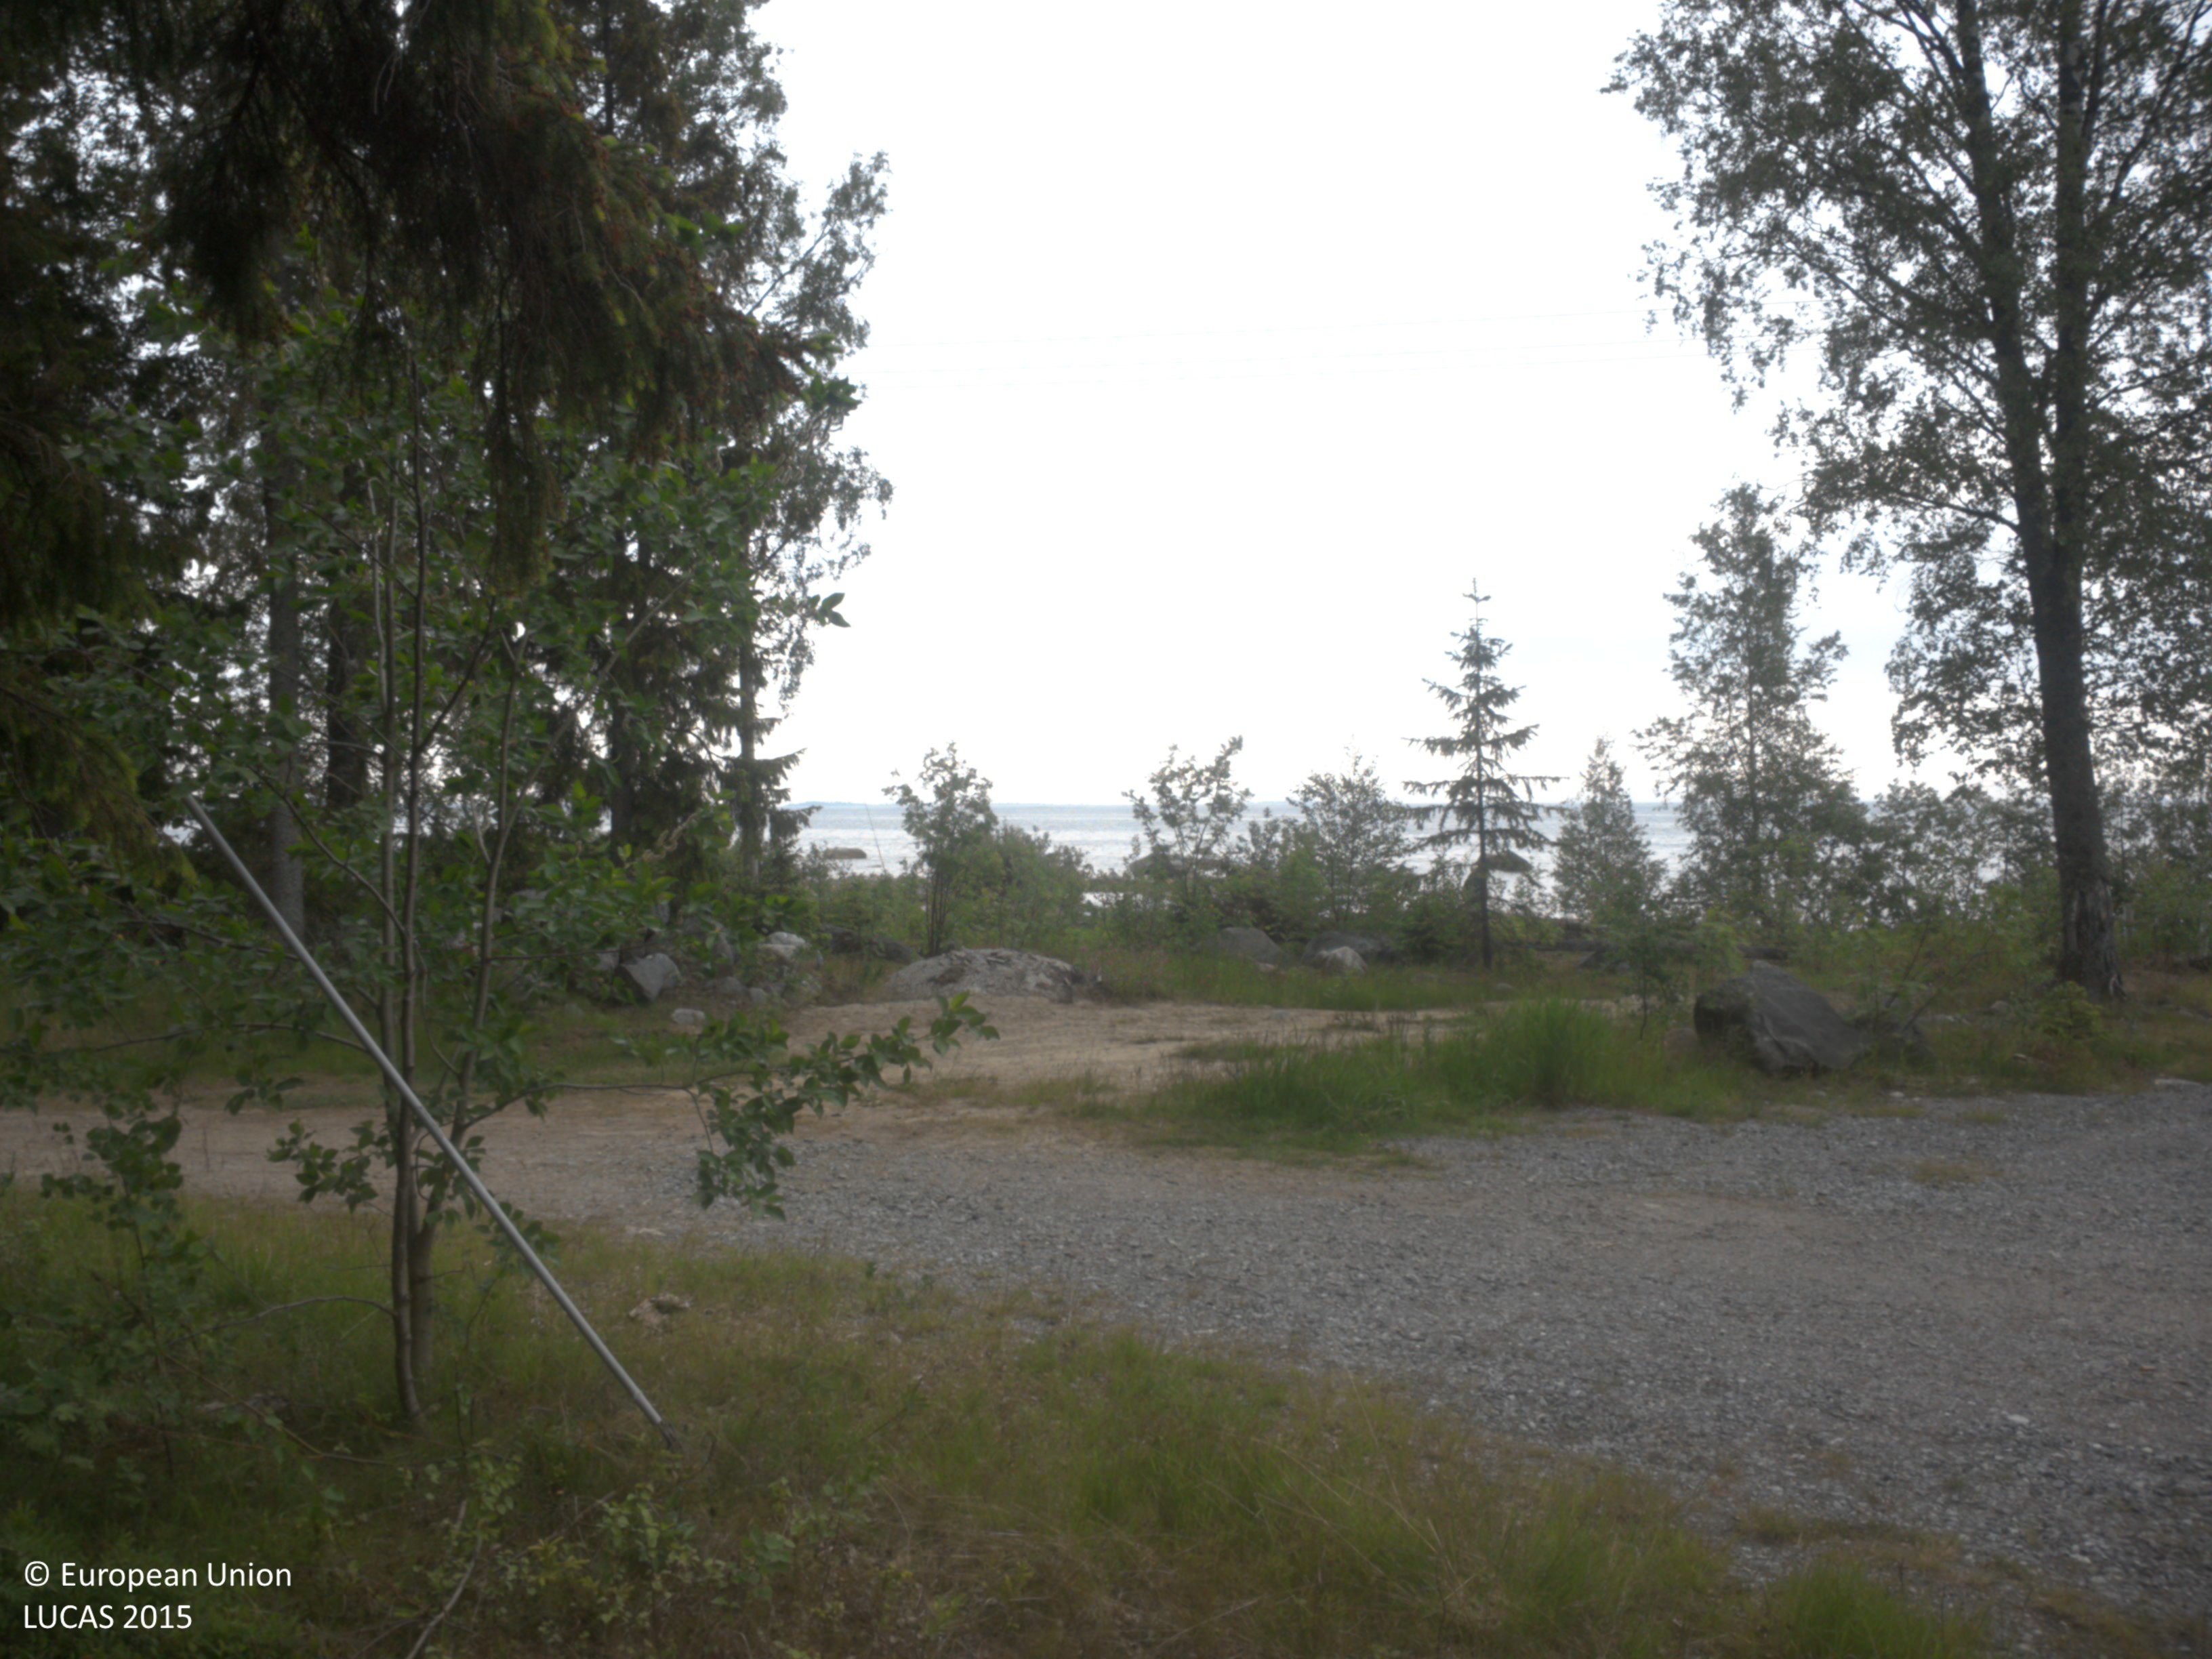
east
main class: Woodland
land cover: Spruce dominated coniferous woodland
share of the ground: 25 - 50 %
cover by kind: coniferous forest trees 50 %, consolidated bare surface 40 %, herbaceous plants 10 %
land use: Residential
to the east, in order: Spruce dominated coniferous woodland; Grass margins; Tracks; Grass margins; Sand; Grassland with sparse tree/shrub cover; Electric lines; Broadleaved woodland; Sand; Rocks and stones
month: June
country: SE
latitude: 63.5977
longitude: 19.8783
